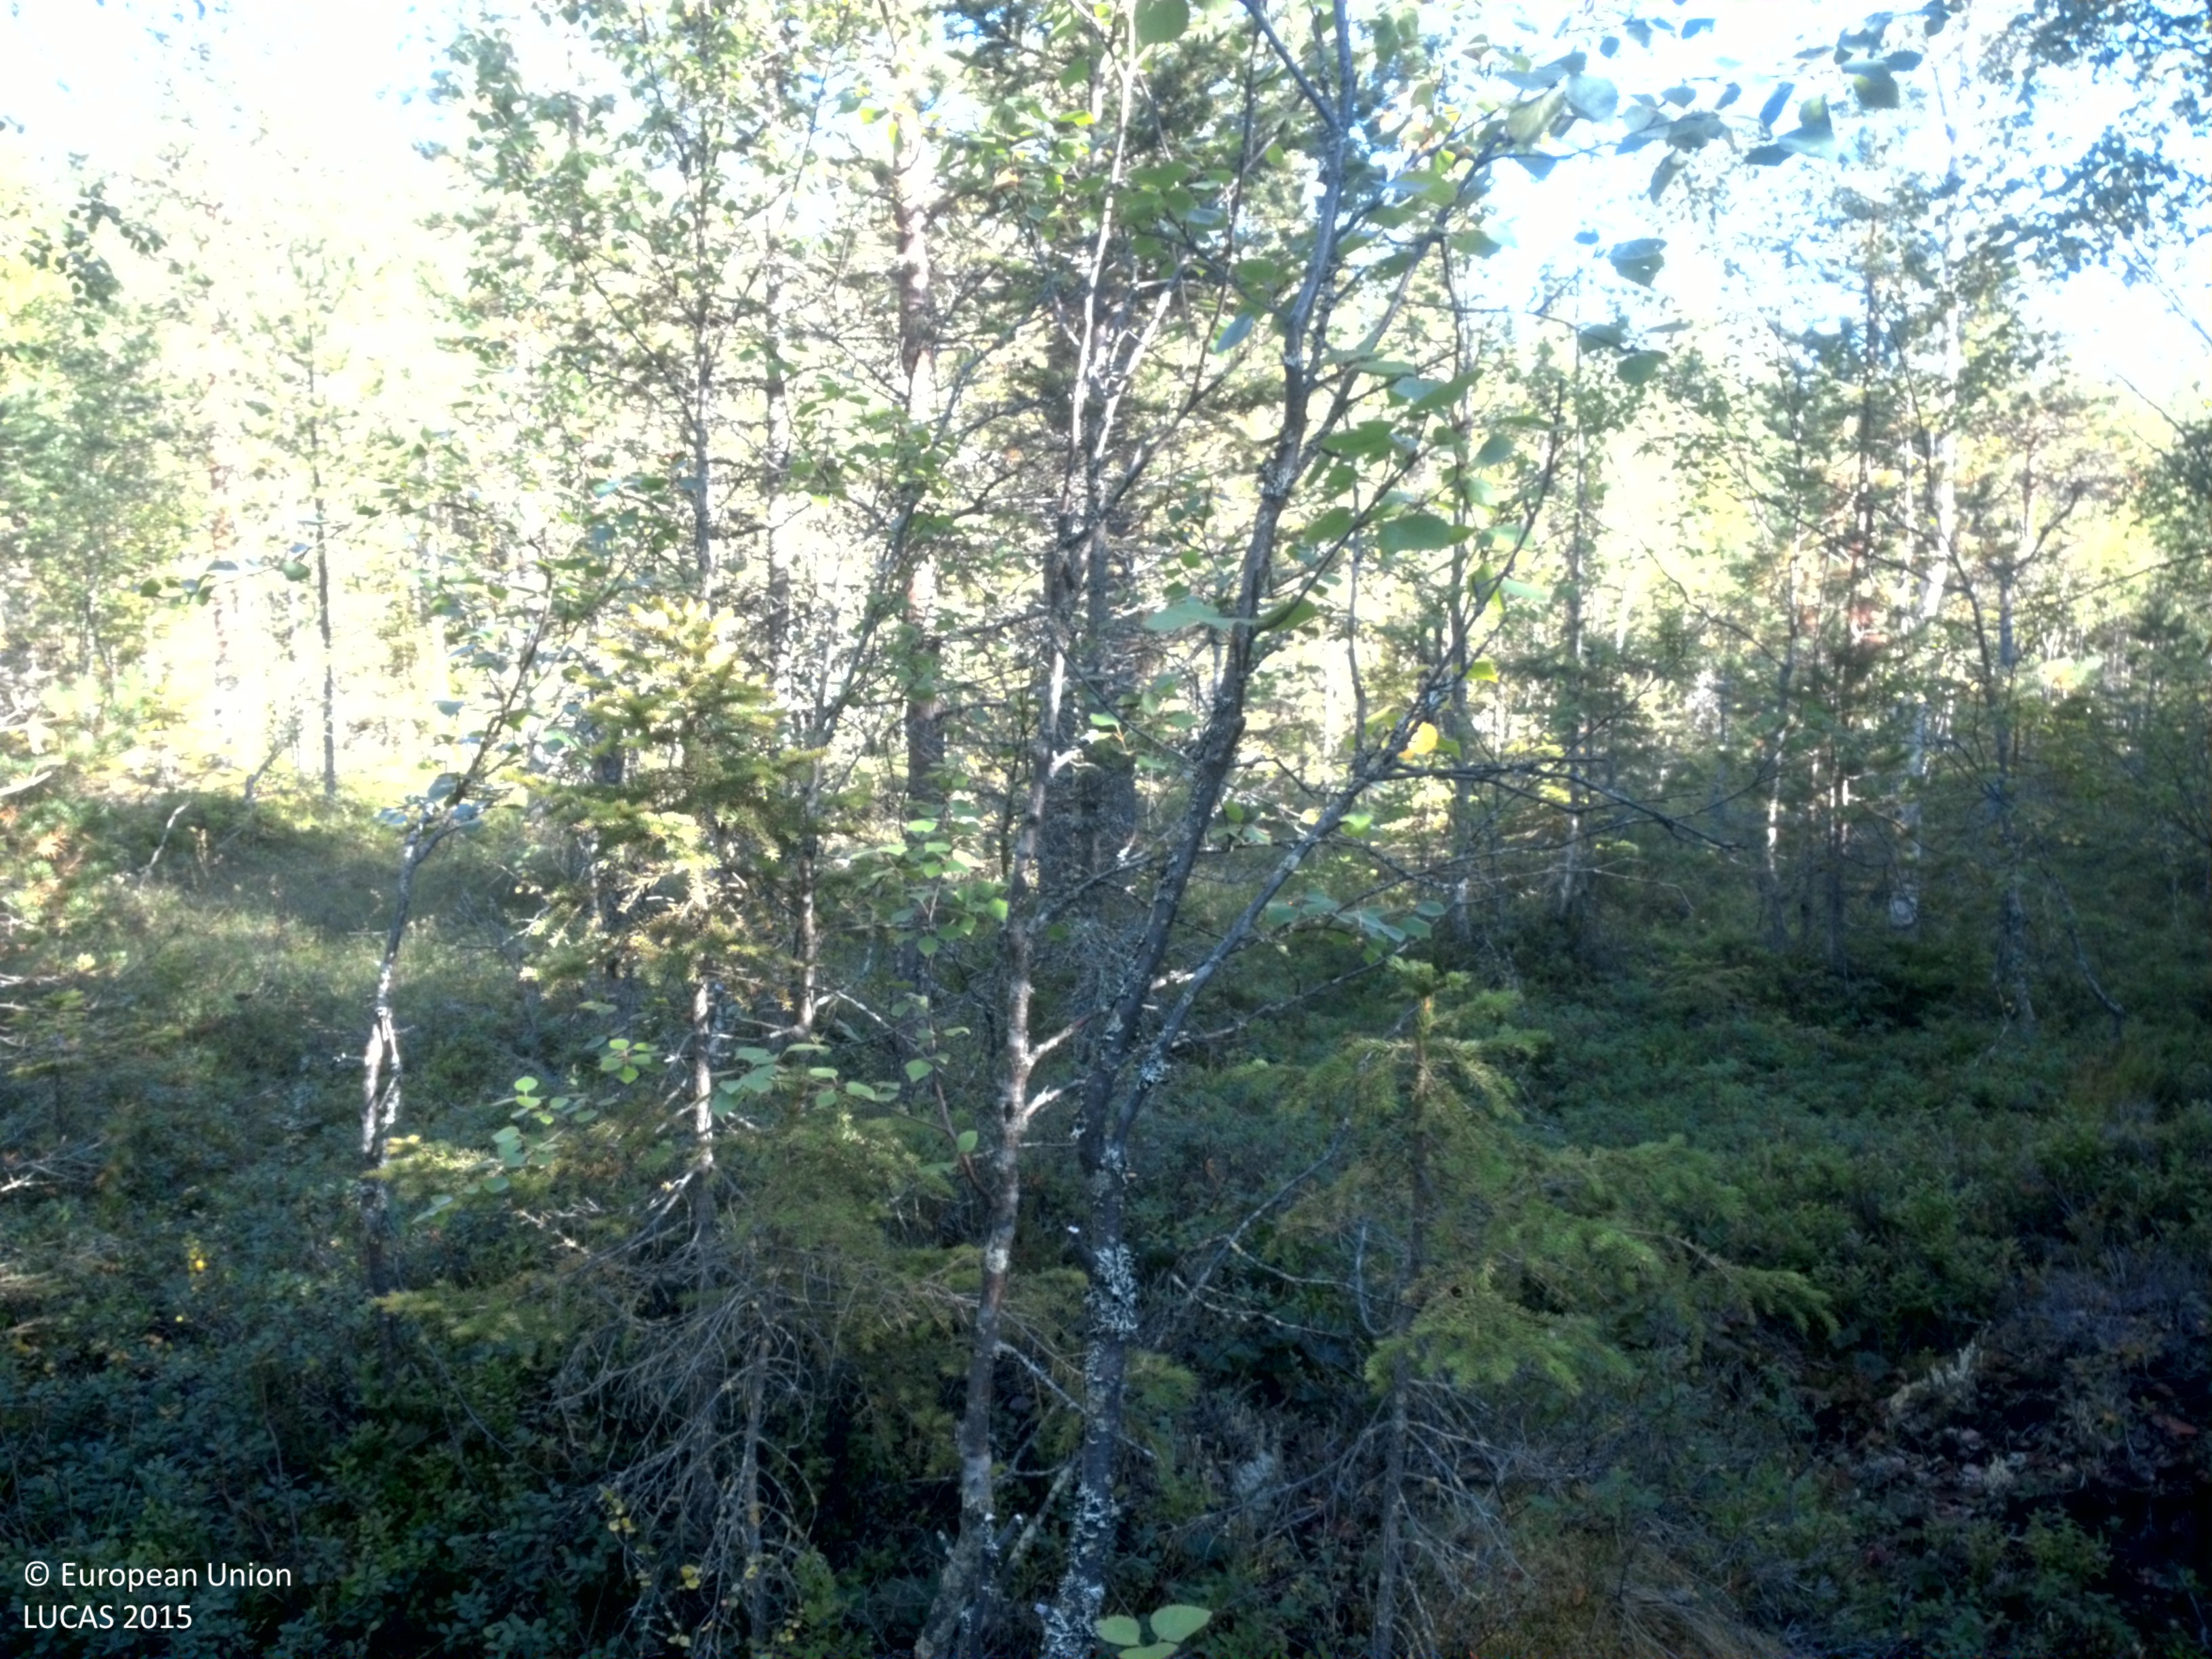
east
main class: Woodland
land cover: Spruce dominated mixed woodland
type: boreal forest
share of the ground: 50 - 75 %
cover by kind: shrubs 40 %, coniferous forest trees 35 %, broadleaved forest trees 15 %, herbaceous plants 5 %, lichens and mosses 5 %
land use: Forestry
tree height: > 5 m
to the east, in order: Spruce dominated mixed woodland; Ditches and canals; Pine dominated mixed woodland; Pine dominated coniferous woodland; Pine dominated mixed woodland
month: August
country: SE
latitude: 64.5742
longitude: 18.4220
